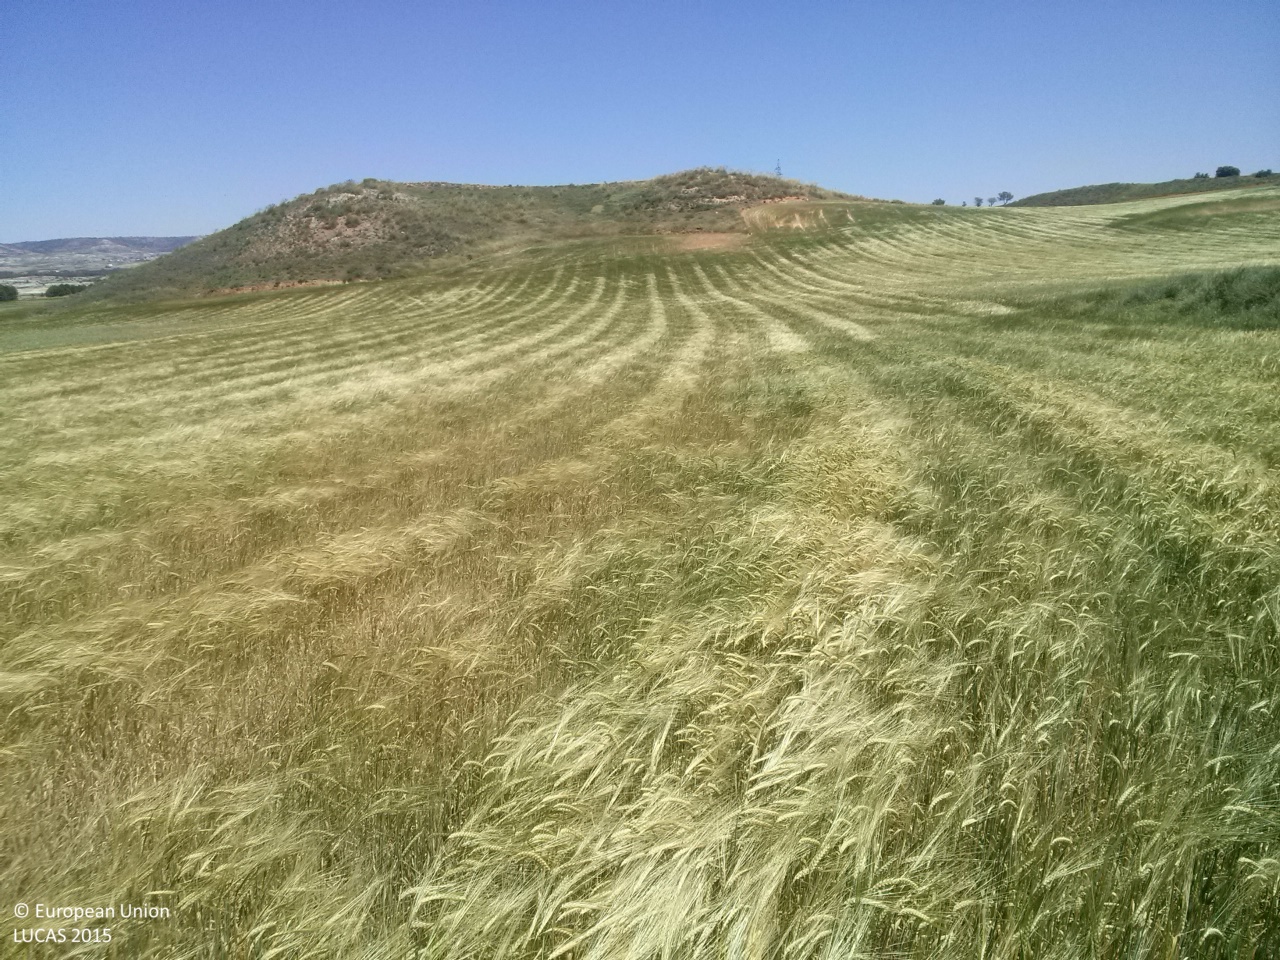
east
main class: Cropland
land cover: Barley
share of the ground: > 75 %
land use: Agriculture (excluding fallow land and kitchen gardens)
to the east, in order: Barley; Shrubland without tree cover; Barley; Grassland without tree/shrub cover
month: May
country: ES
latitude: 40.3282
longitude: -2.7481
